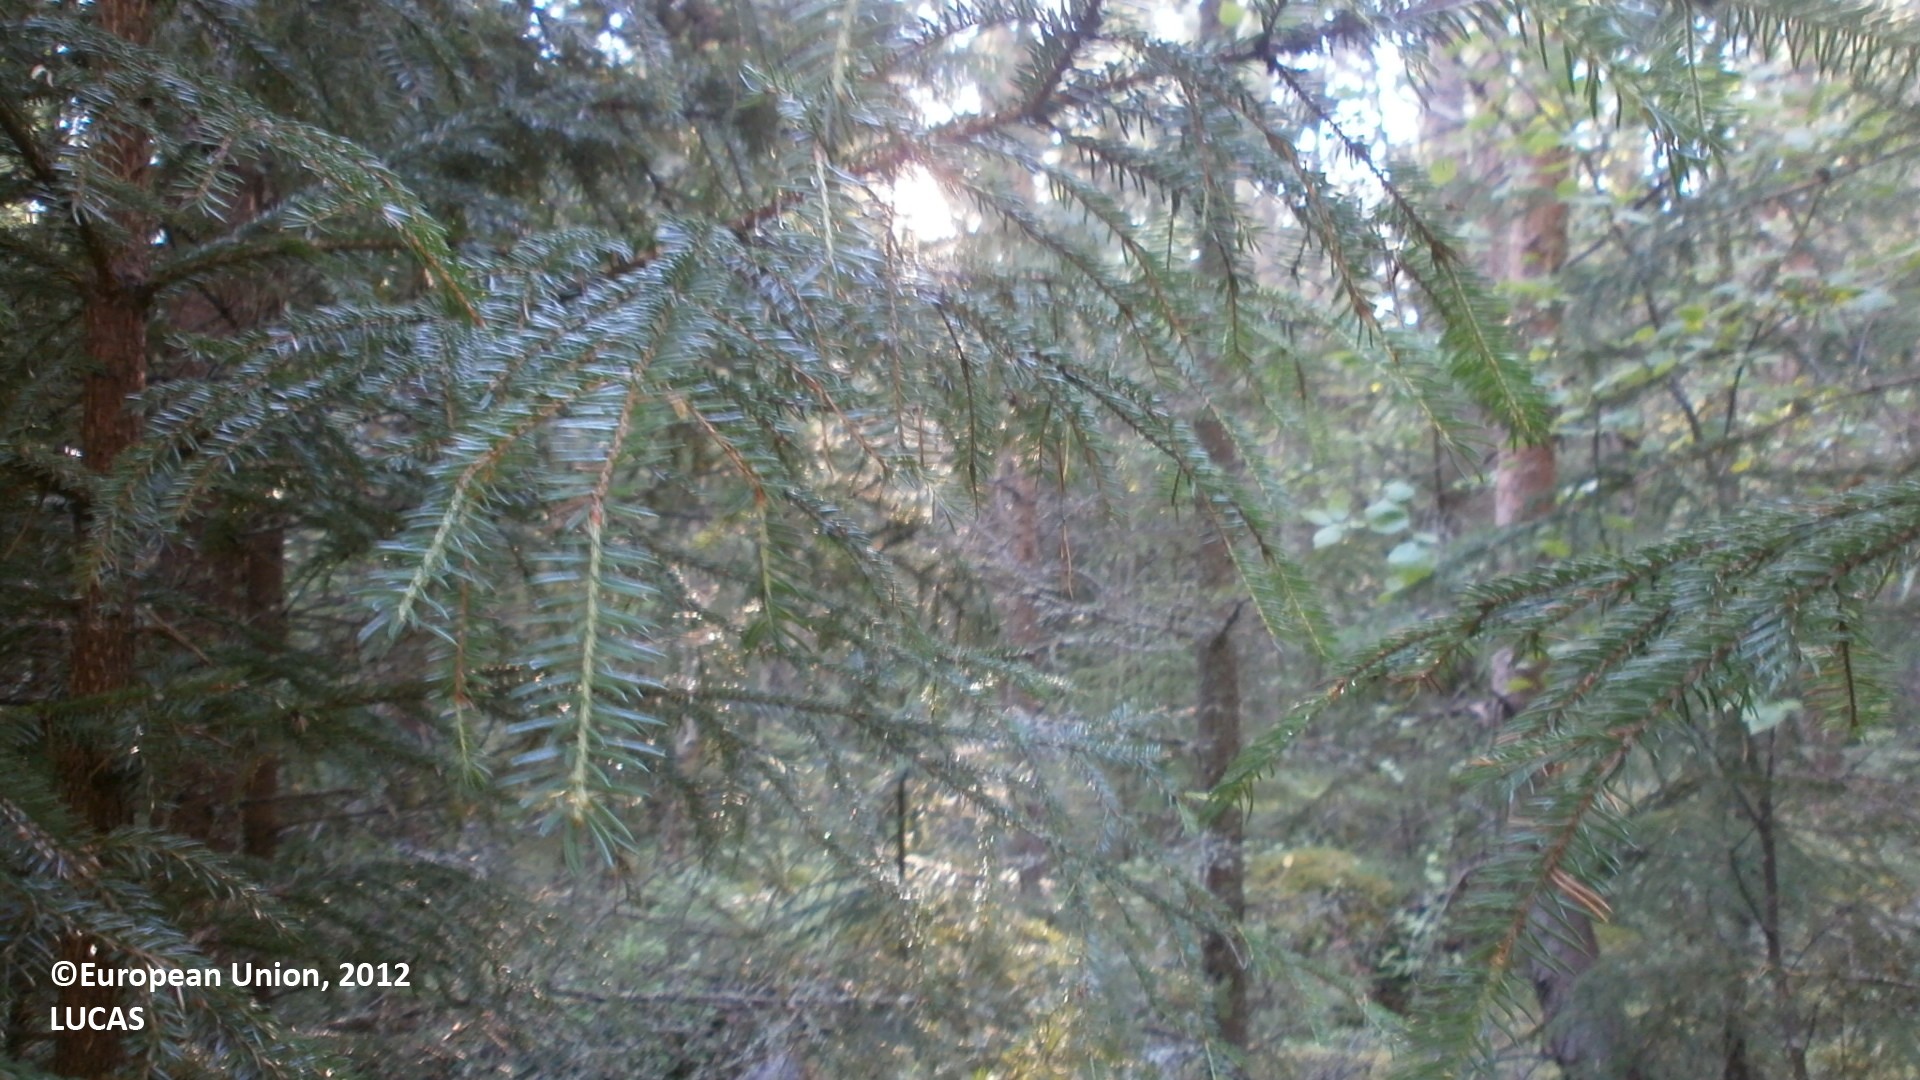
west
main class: Woodland
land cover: Pine dominated coniferous woodland
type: boreal forest
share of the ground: > 75 %
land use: Forestry
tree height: > 5 m
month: July
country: FI
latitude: 64.1015
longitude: 23.6218
